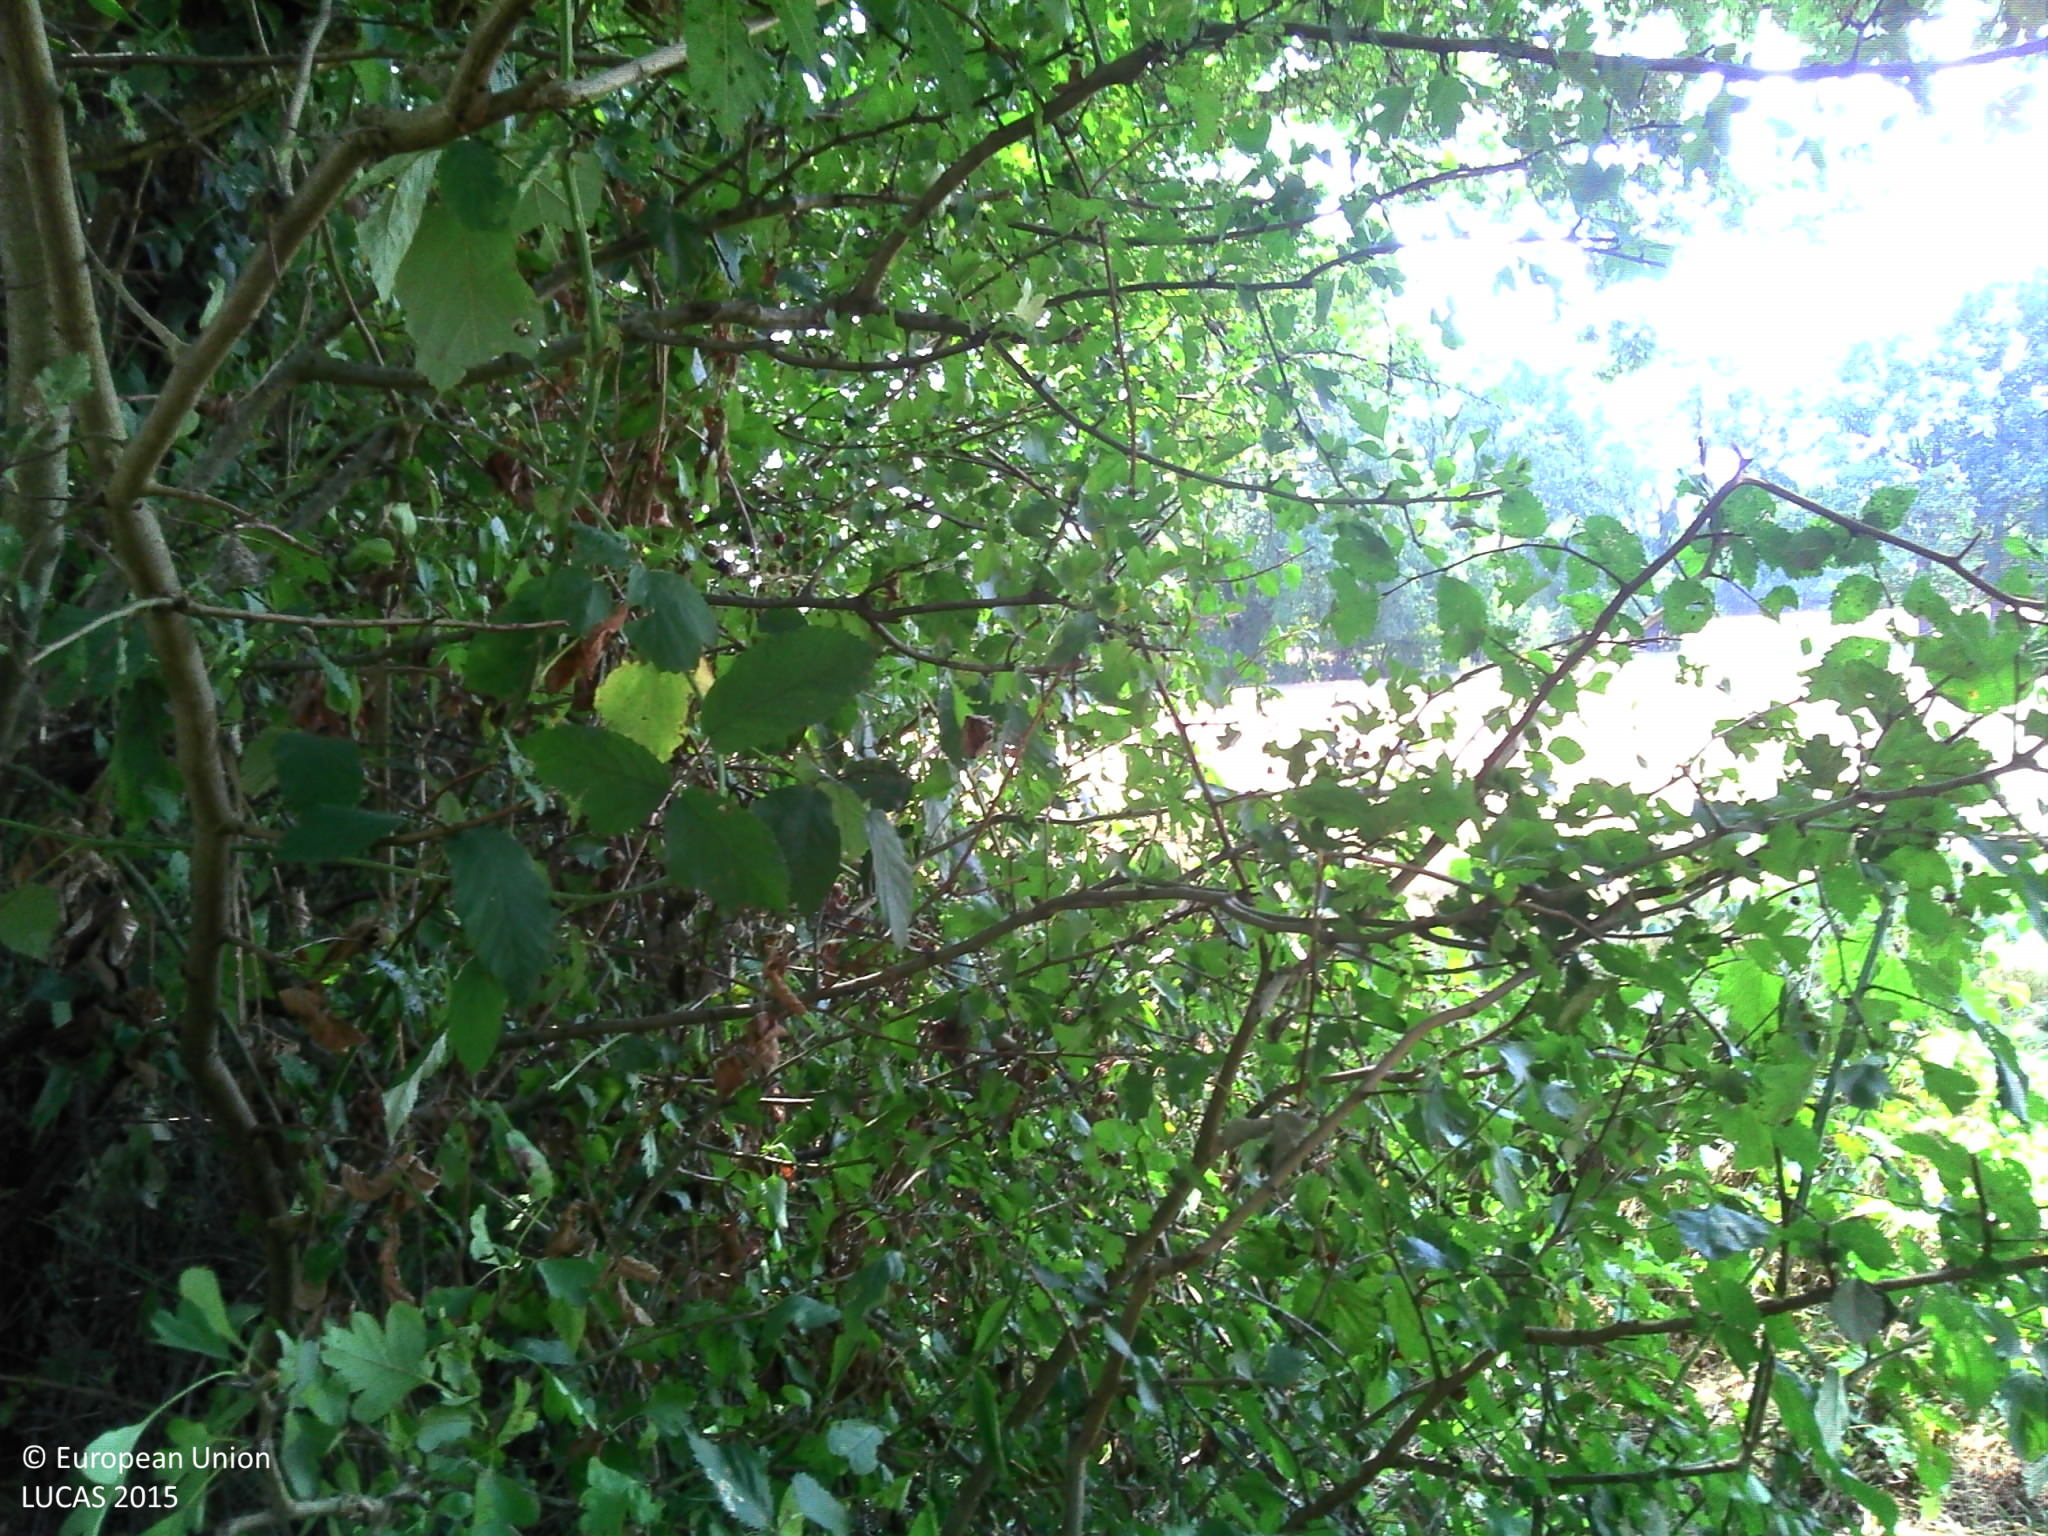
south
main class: Grassland
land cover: Grassland without tree/shrub cover
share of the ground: > 75 %
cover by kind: herbaceous plants 100 %
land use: Agriculture (excluding fallow land and kitchen gardens)
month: August
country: FR
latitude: 46.7684
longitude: 2.9380
